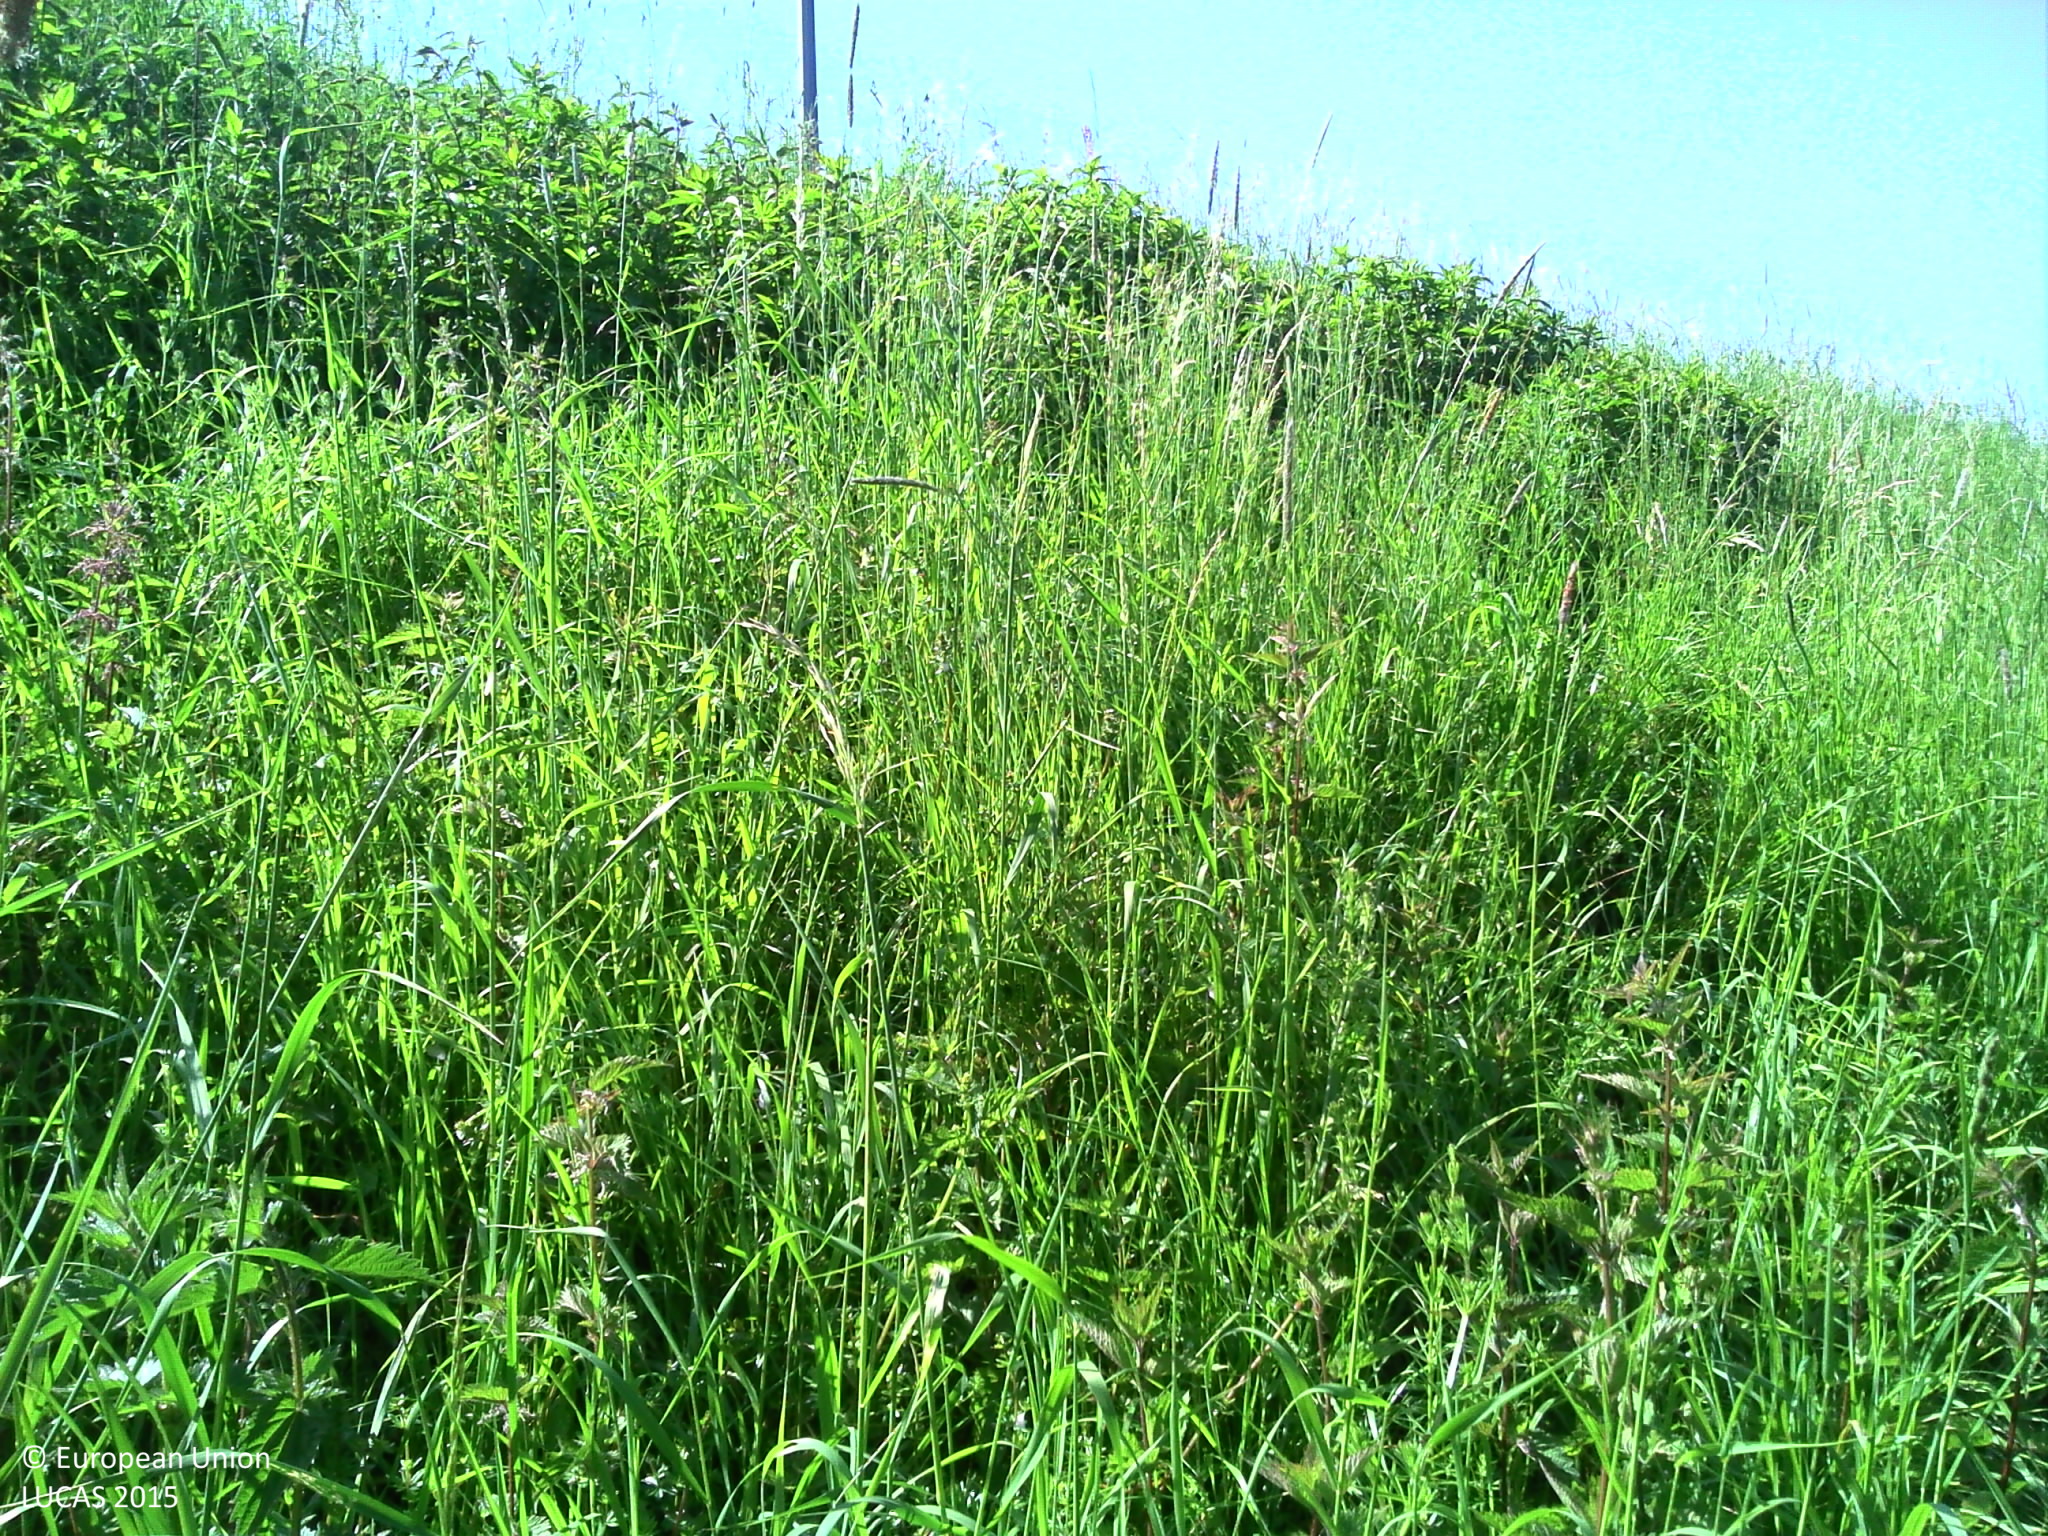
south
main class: Grassland
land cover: Spontaneously vegetated surfaces
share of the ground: > 75 %
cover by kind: herbaceous plants 100 %
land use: Semi-natural and natural areas not in use
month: June
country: BE
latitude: 50.5172
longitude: 5.6970
